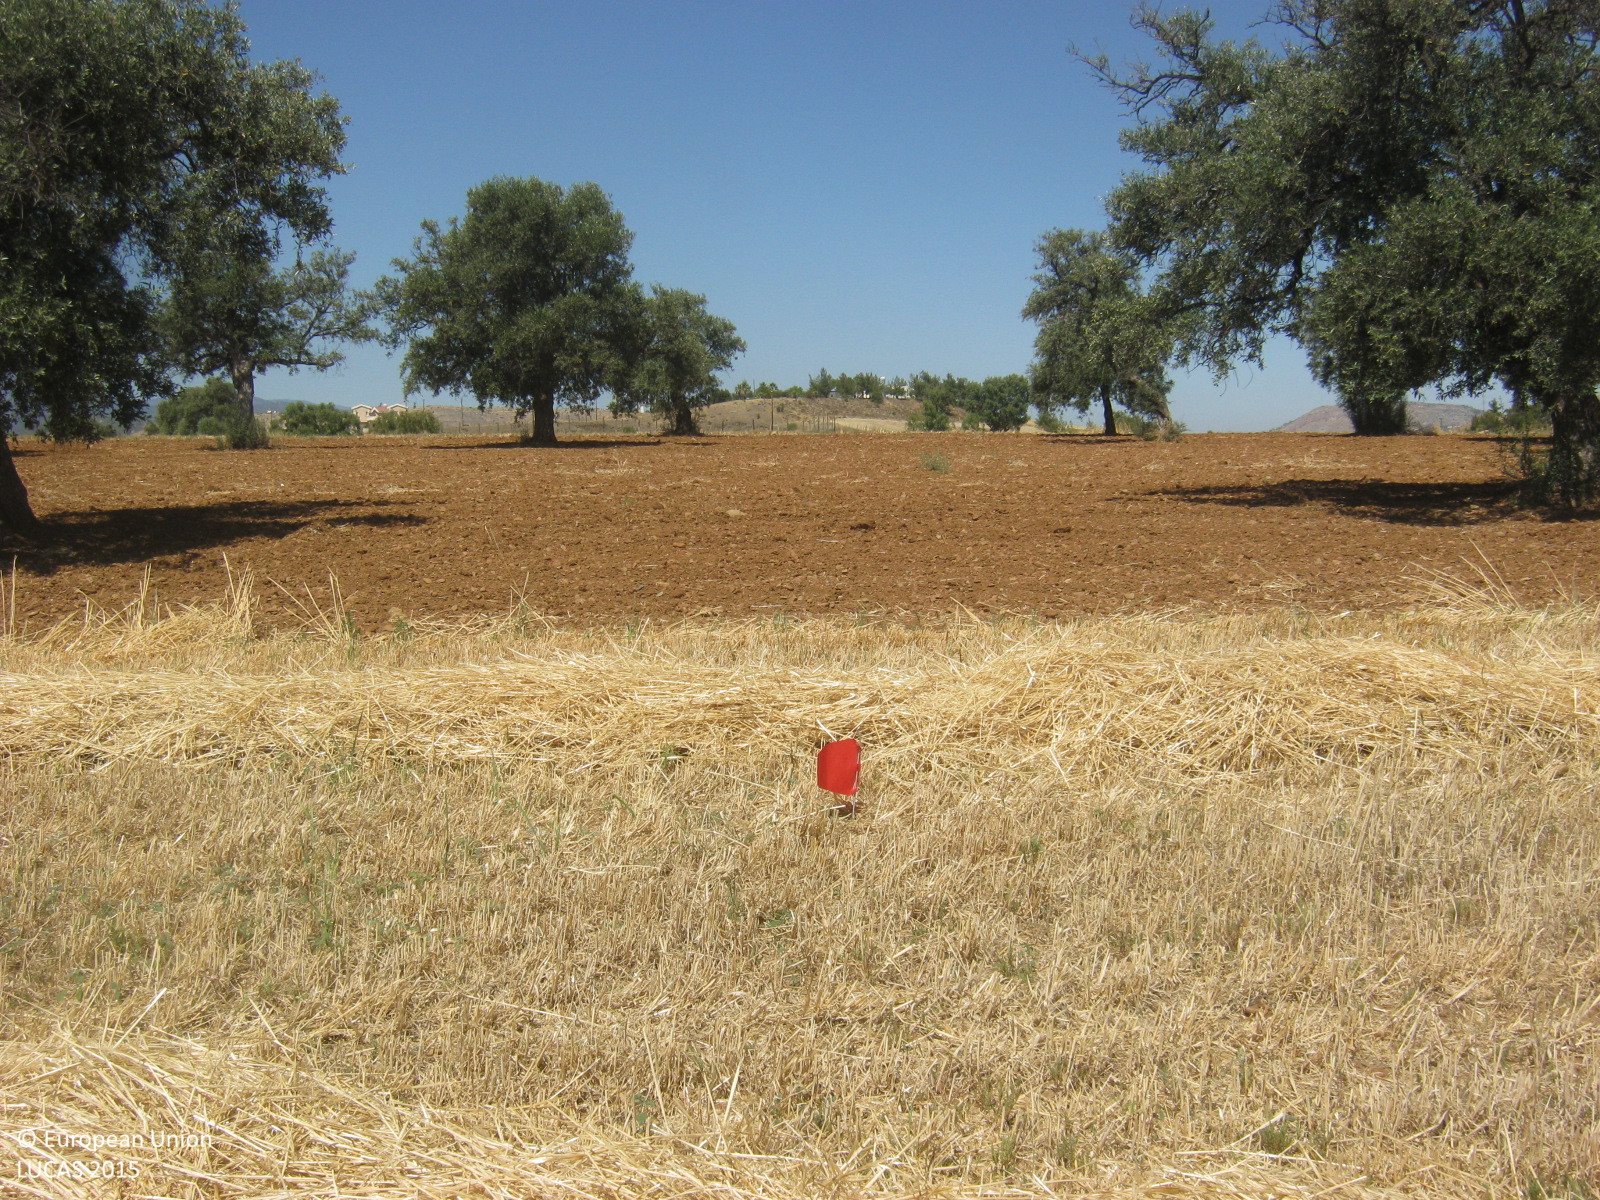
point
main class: Cropland
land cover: Barley
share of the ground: < 10 %
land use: Agriculture (excluding fallow land and kitchen gardens)
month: June
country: CY
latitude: 35.0271
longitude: 33.1880
